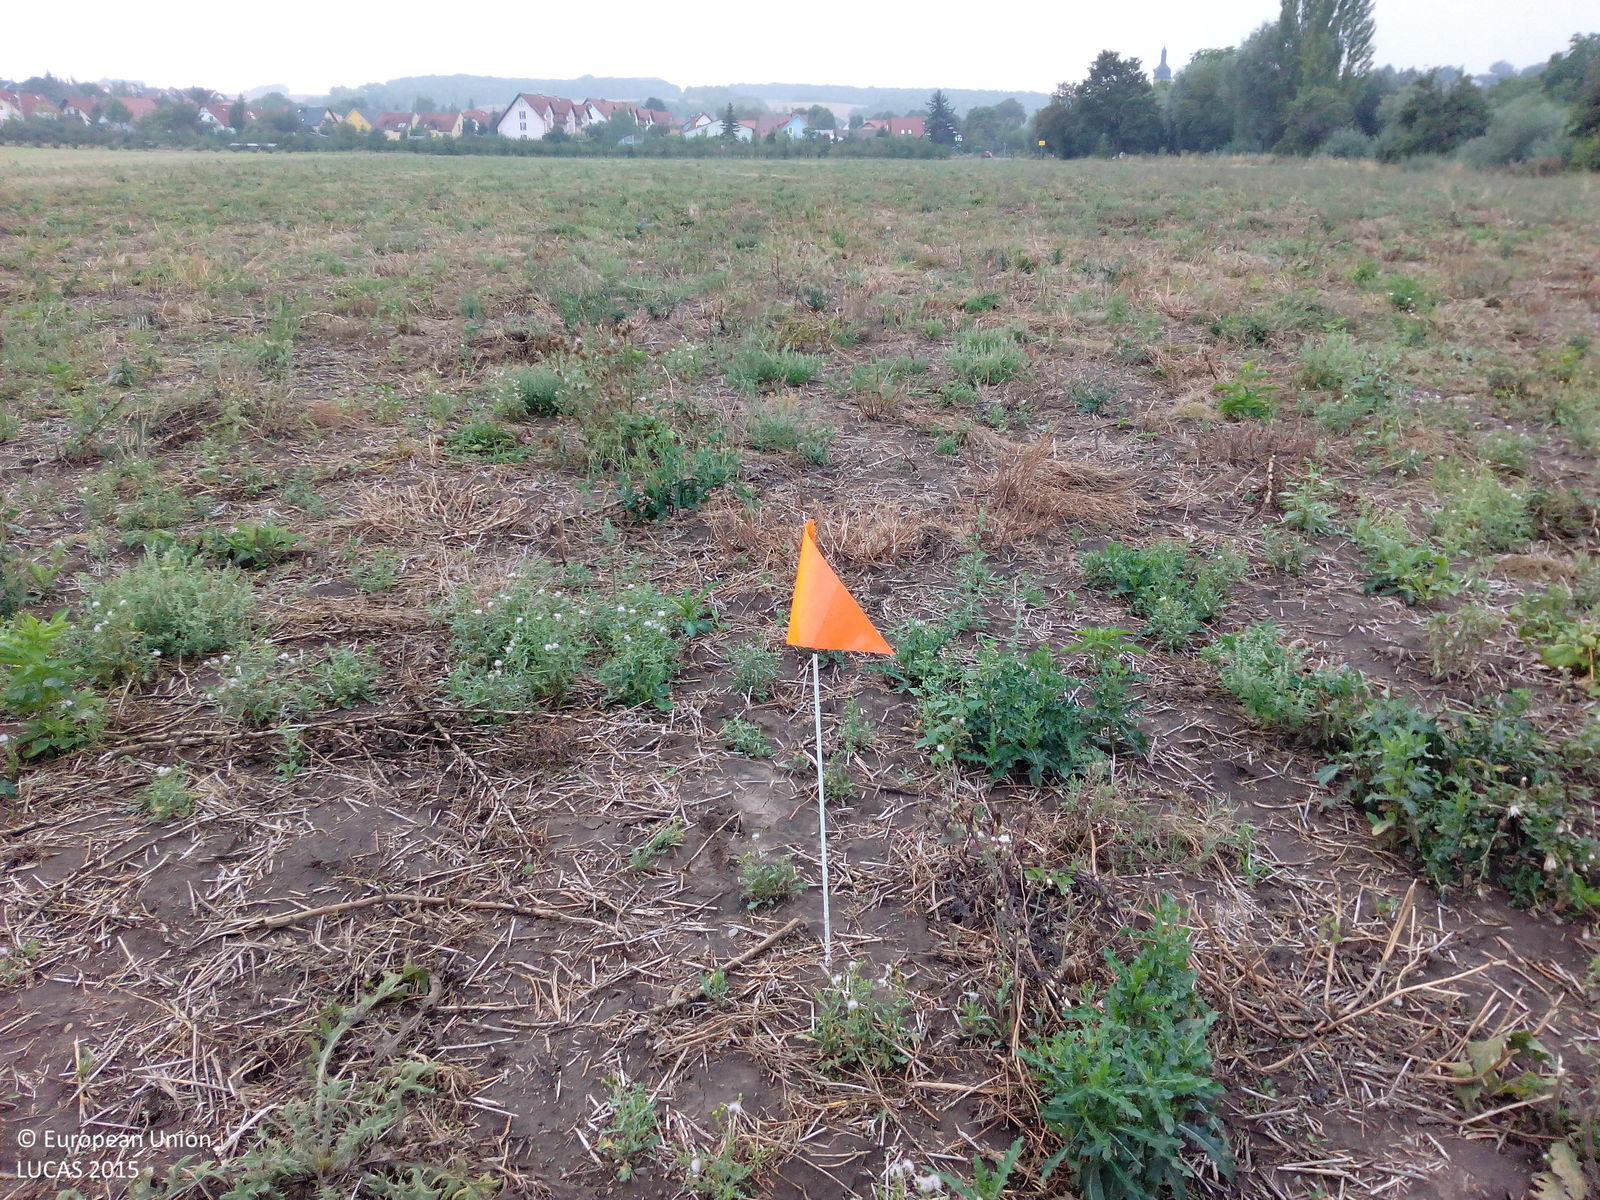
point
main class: Grassland
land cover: Spontaneously vegetated surfaces
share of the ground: 25 - 50 %
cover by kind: unconsolidated bare surface 60 %, herbaceous plants 40 %
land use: Fallow land
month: August
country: DE
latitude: 51.0254
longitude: 10.9550
